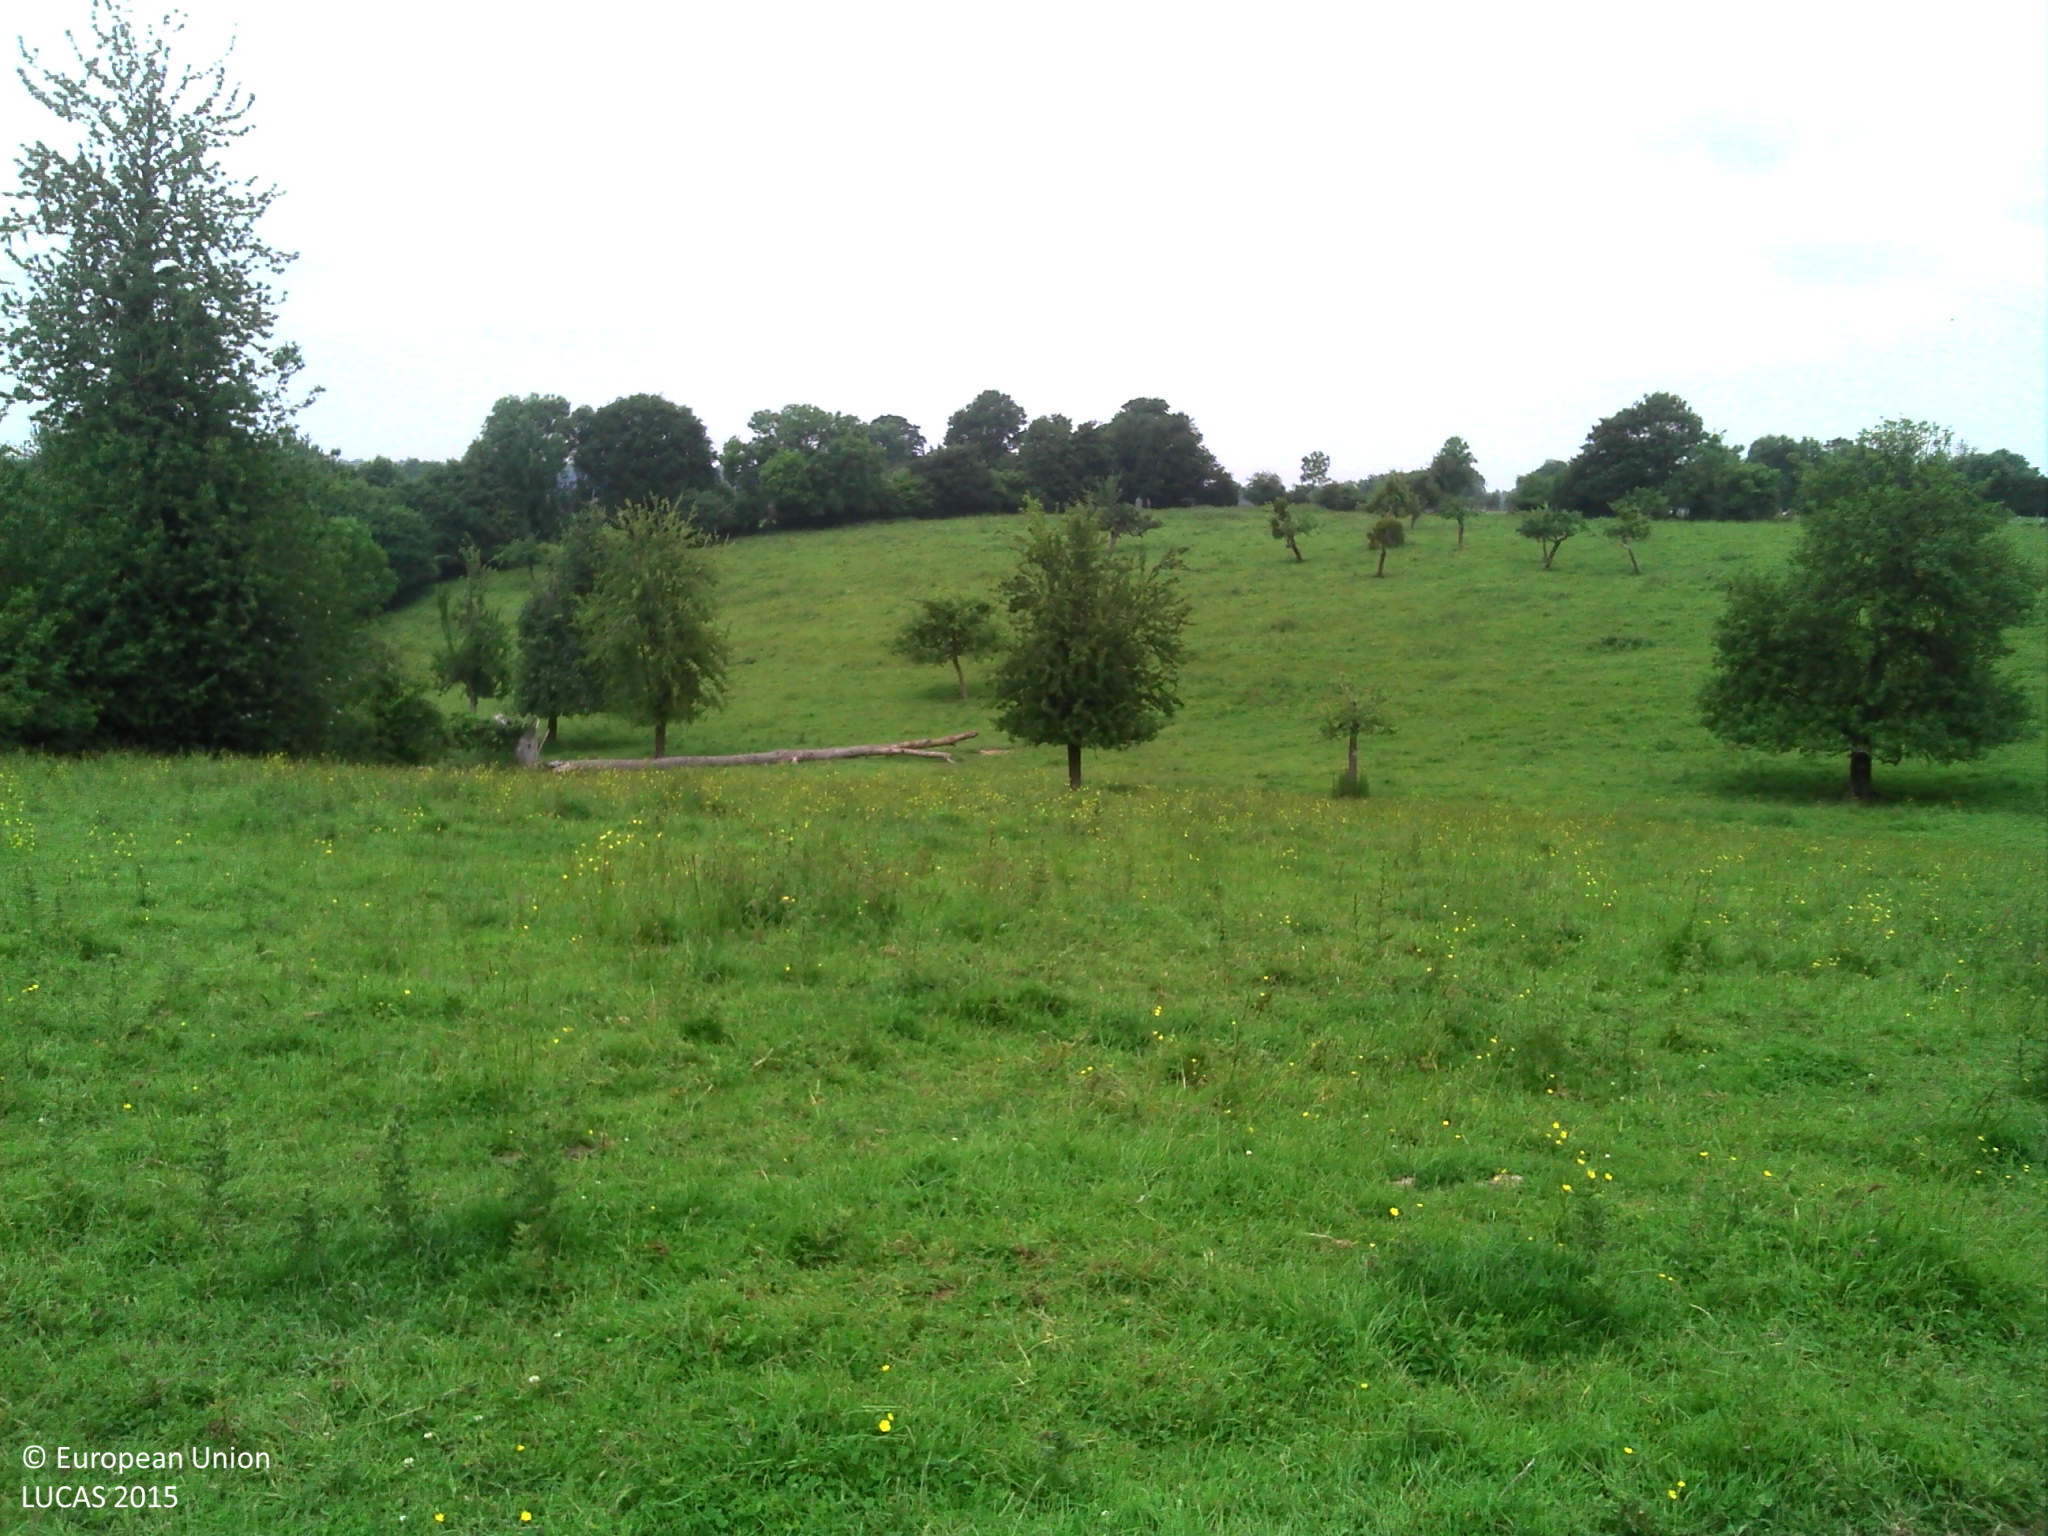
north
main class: Grassland
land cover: Grassland with sparse tree/shrub cover
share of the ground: > 75 %
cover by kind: herbaceous plants 95 %, broadleaved forest trees 5 %
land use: Agriculture (excluding fallow land and kitchen gardens)
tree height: > 5 m
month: June
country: FR
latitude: 49.2193
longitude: 0.0152
